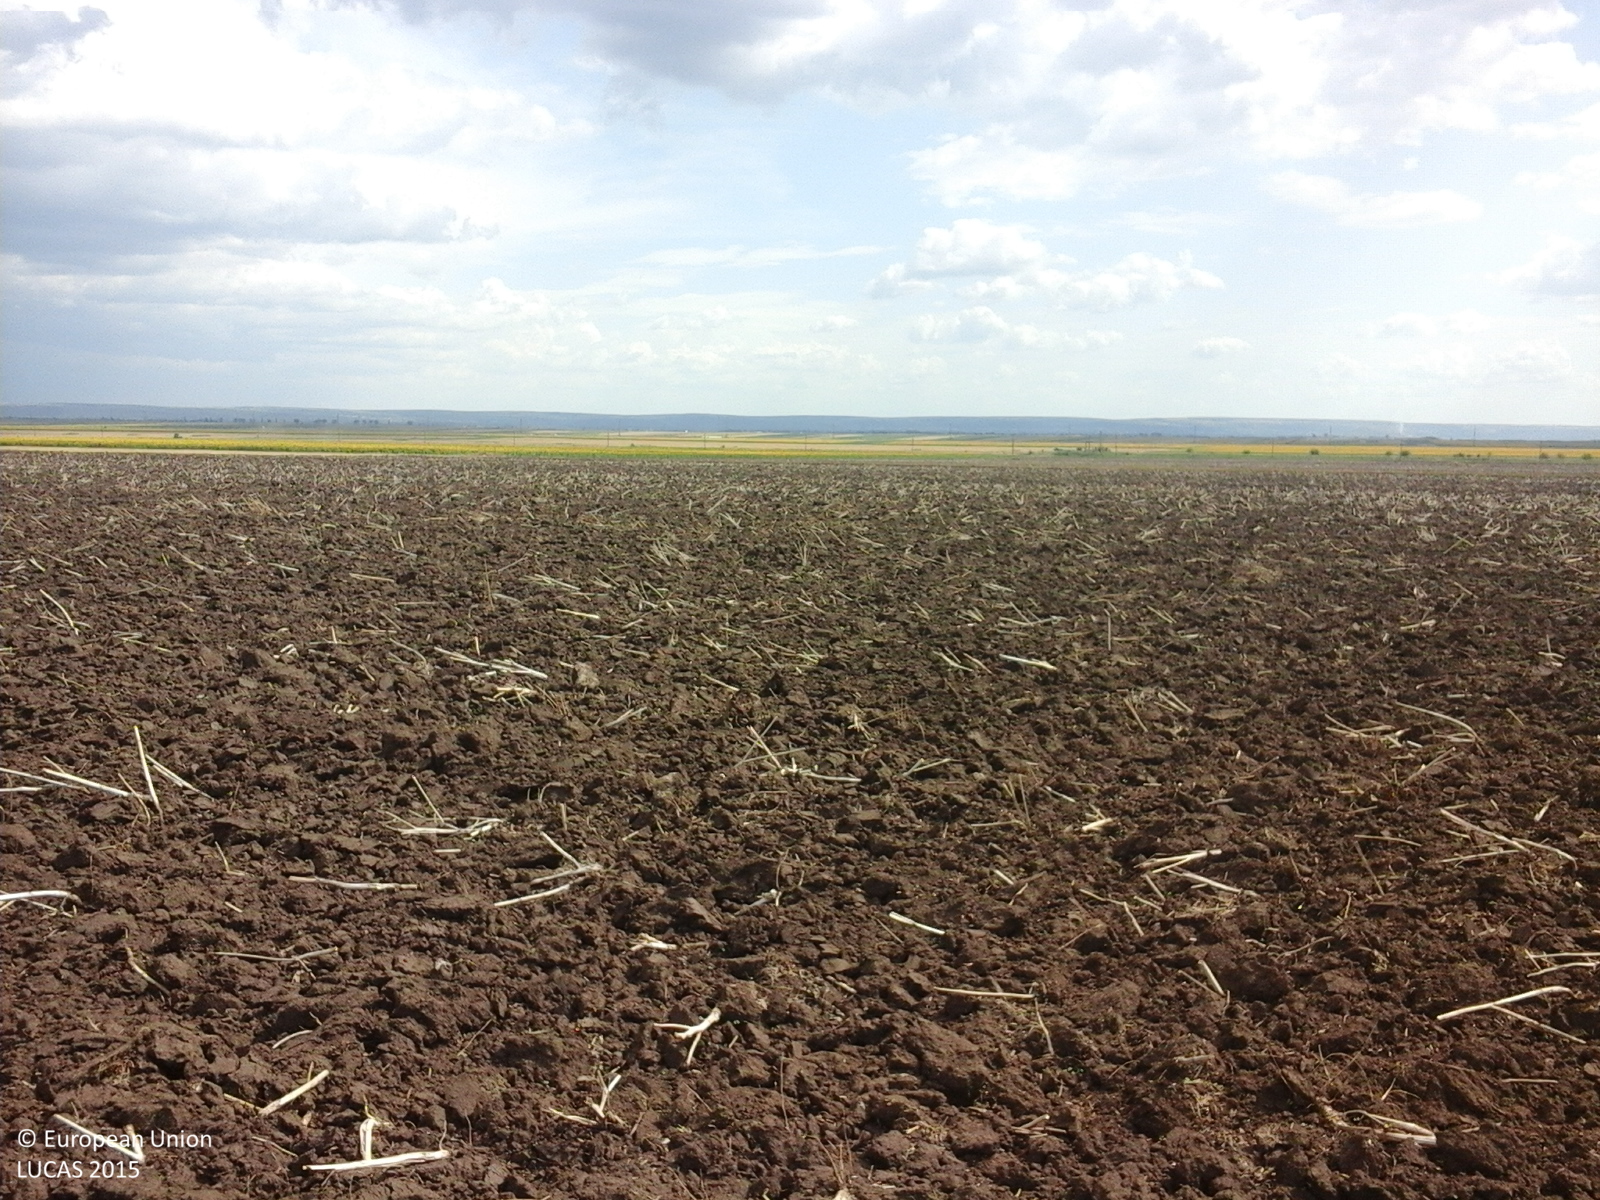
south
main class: Cropland
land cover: Rape and turnip rape
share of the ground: < 10 %
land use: Agriculture (excluding fallow land and kitchen gardens)
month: July
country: RO
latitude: 43.8088
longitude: 24.3197
